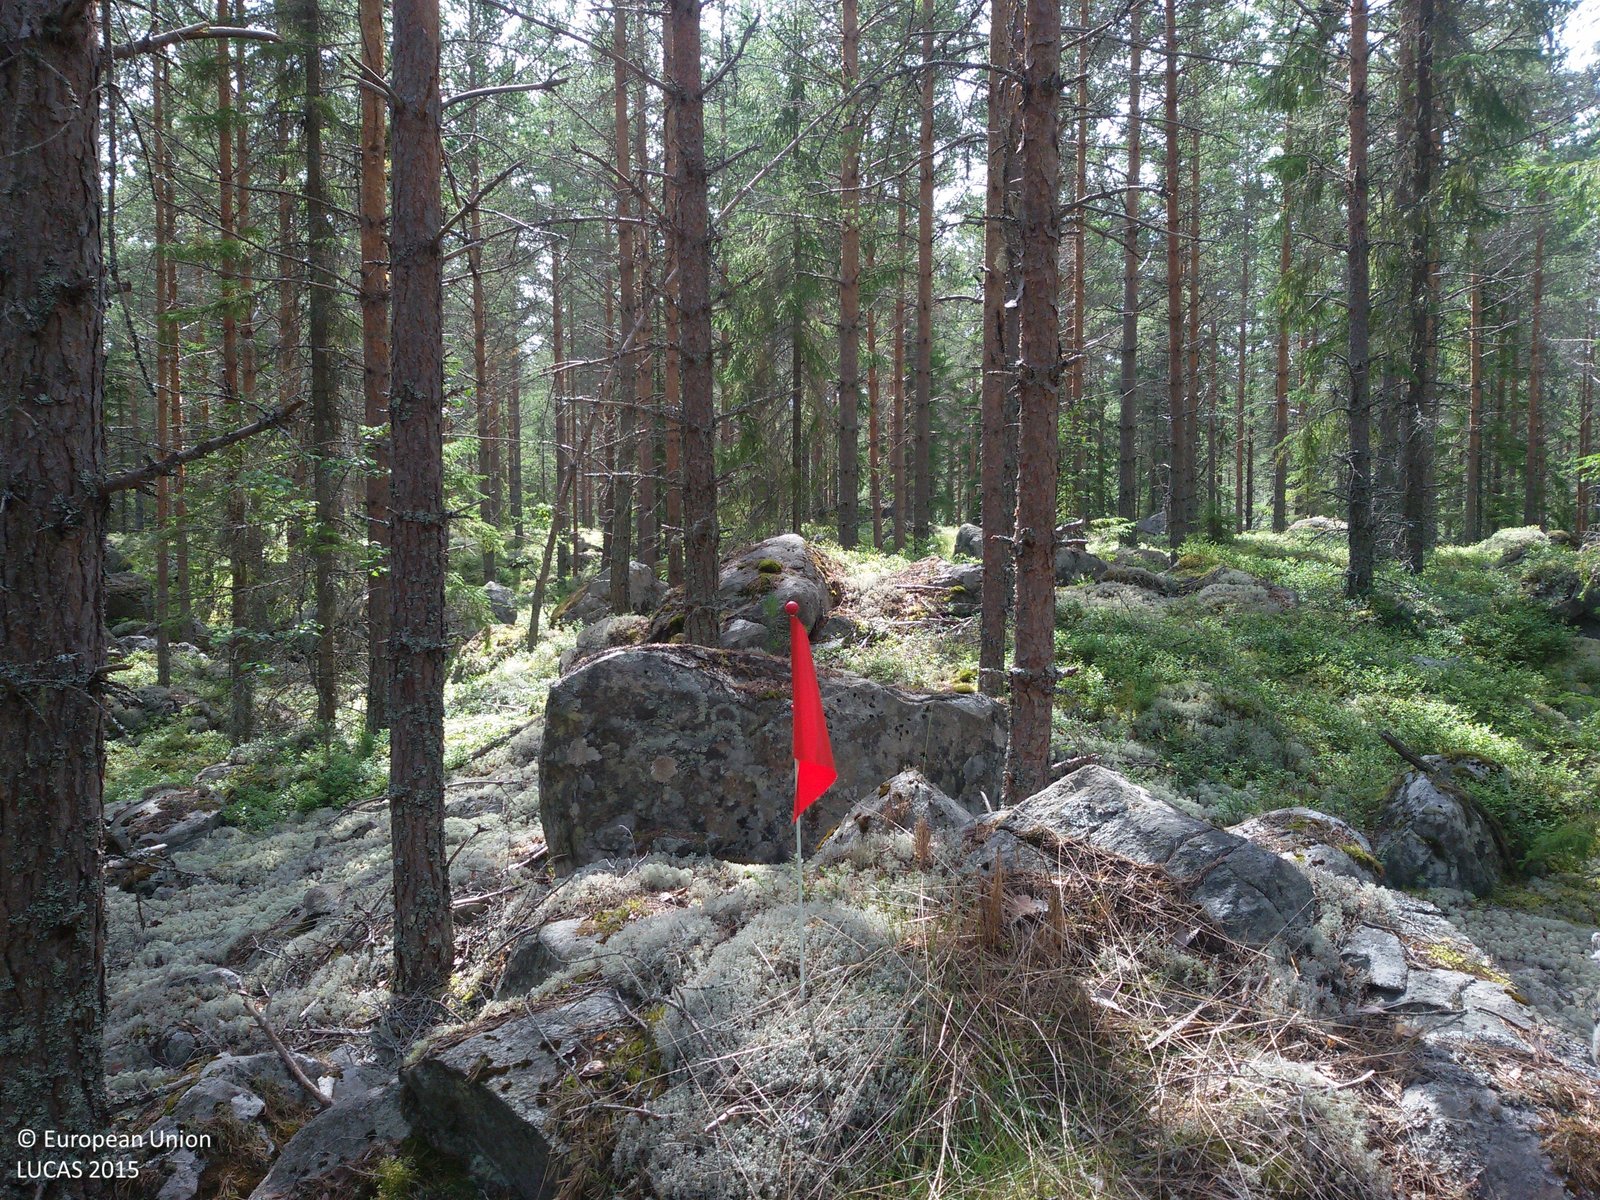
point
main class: Woodland
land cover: Pine dominated coniferous woodland
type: boreal forest
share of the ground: > 75 %
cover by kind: coniferous forest trees 80 %, shrubs 15 %, lichens and mosses 5 %
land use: Forestry
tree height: > 5 m
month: July
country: SE
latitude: 60.6362
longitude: 15.4170
